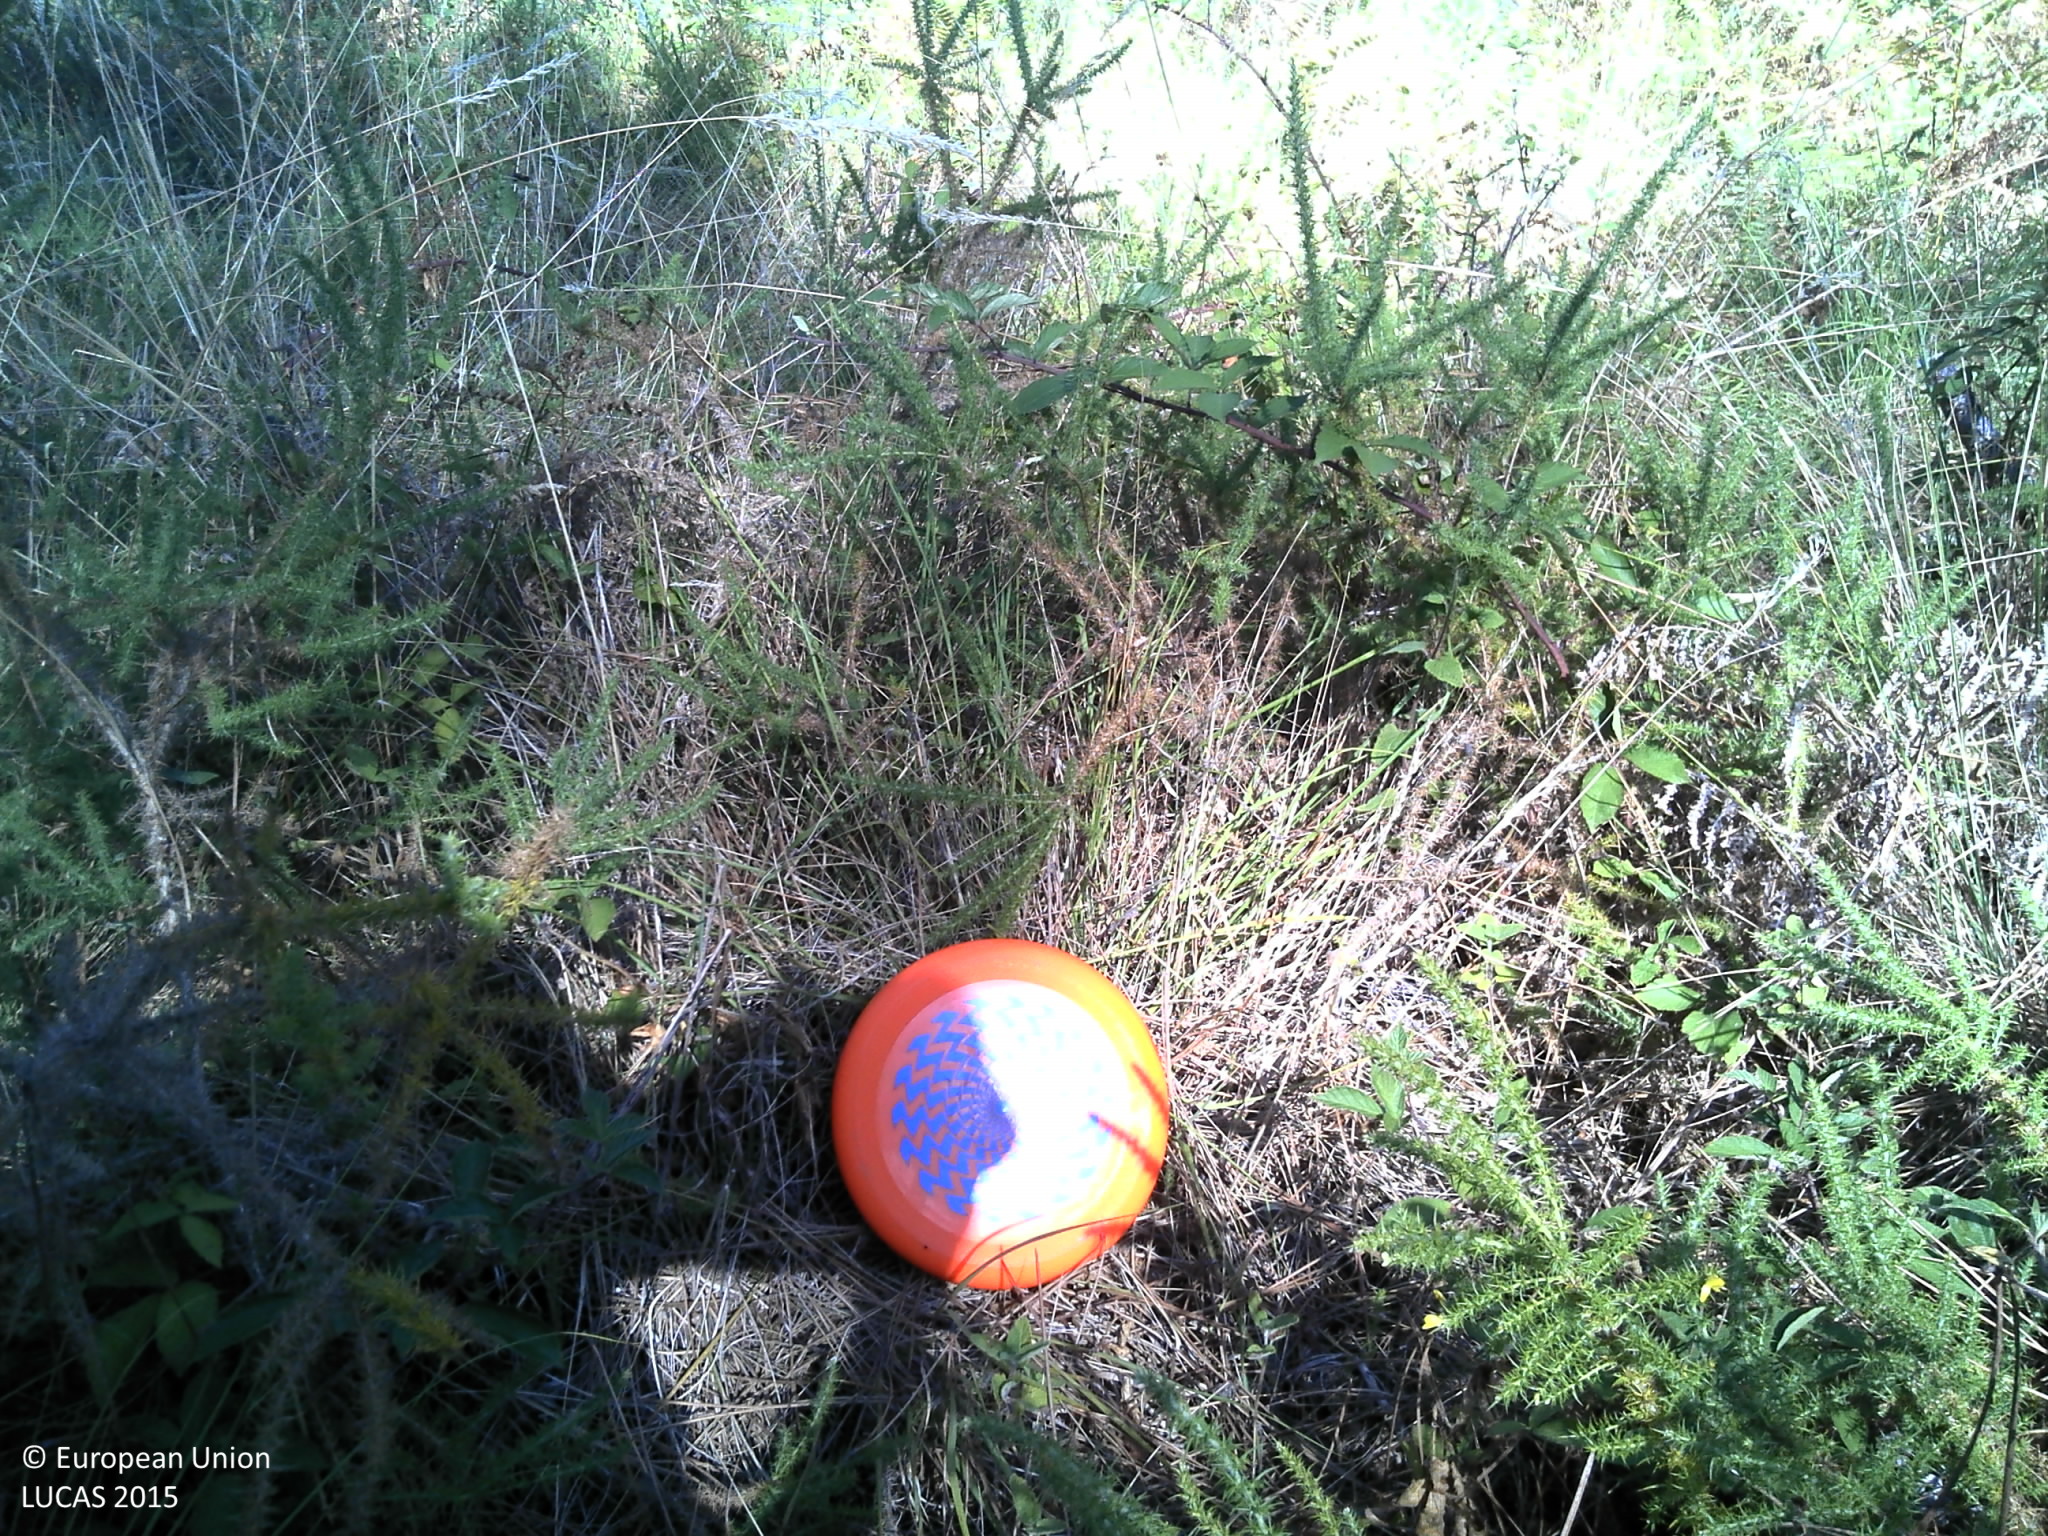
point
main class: Woodland
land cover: Pine dominated coniferous woodland
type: coniferous forest of the mediterranean region
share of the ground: > 75 %
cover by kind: coniferous forest trees 60 %, shrubs 30 %, herbaceous plants 5 %, lichens and mosses 5 %
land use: Forestry
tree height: > 5 m
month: August
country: FR
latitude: 44.5407
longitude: -0.7032
